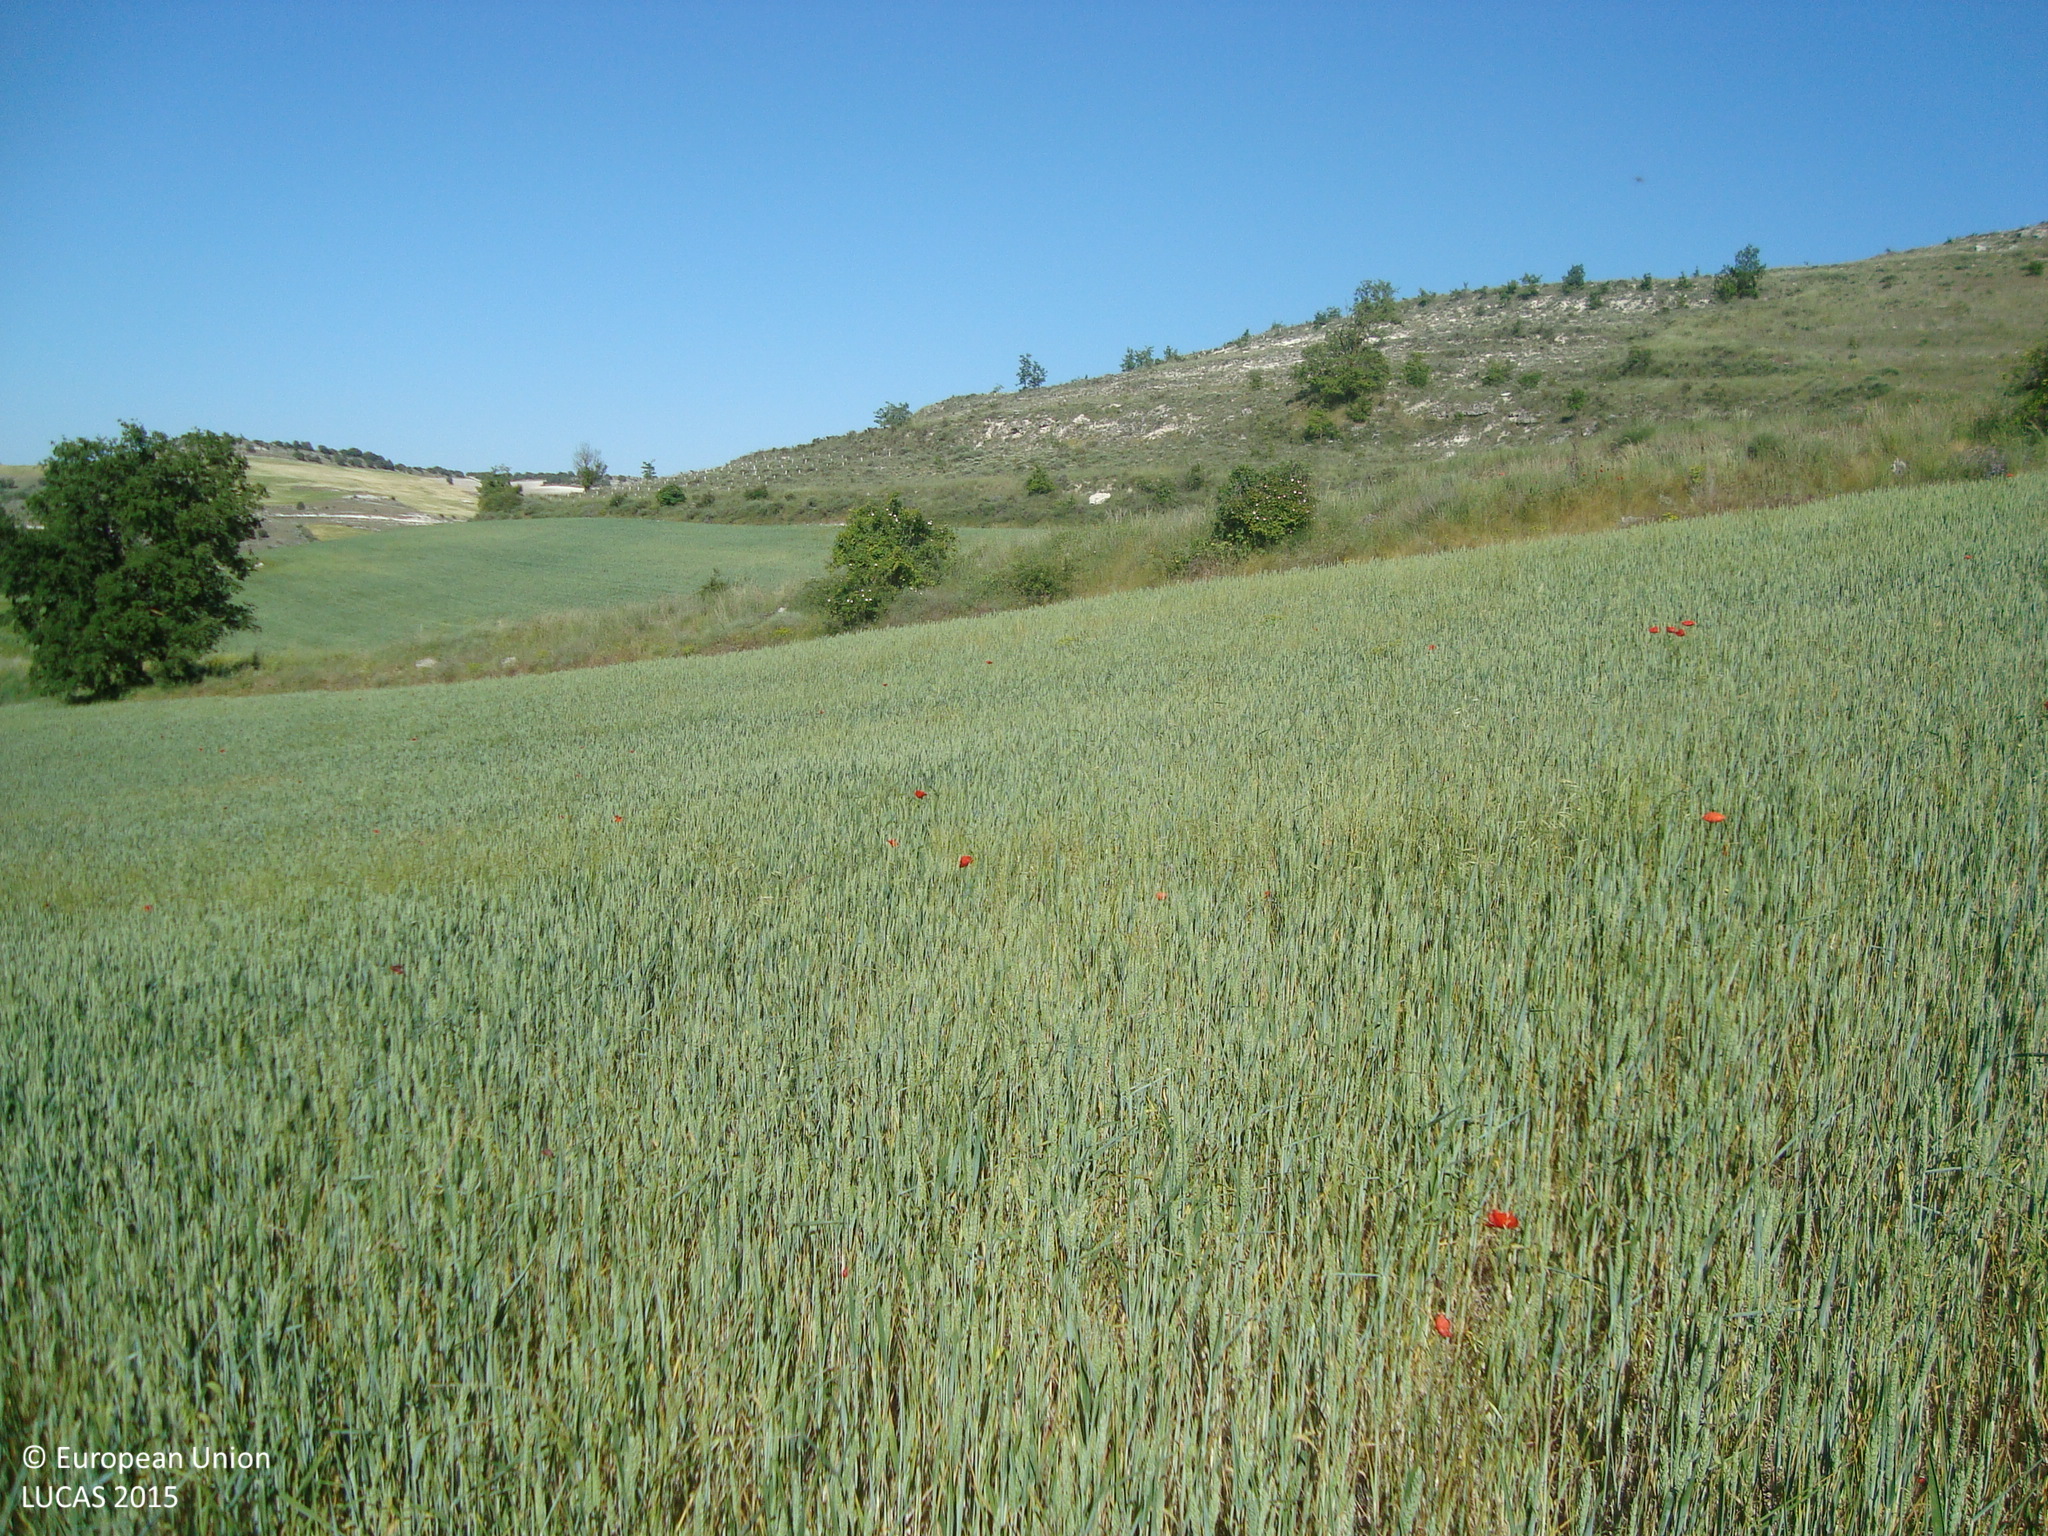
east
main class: Cropland
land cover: Common wheat
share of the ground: > 75 %
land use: Agriculture (excluding fallow land and kitchen gardens)
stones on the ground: < 10 %
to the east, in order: Common wheat; Grass margins; Tracks; Shrubland without tree cover; Common wheat; Grassland with sparse tree/shrub cover; Common wheat; Shrubland with sparse tree cover
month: May
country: ES
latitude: 41.5206
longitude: -4.0651
